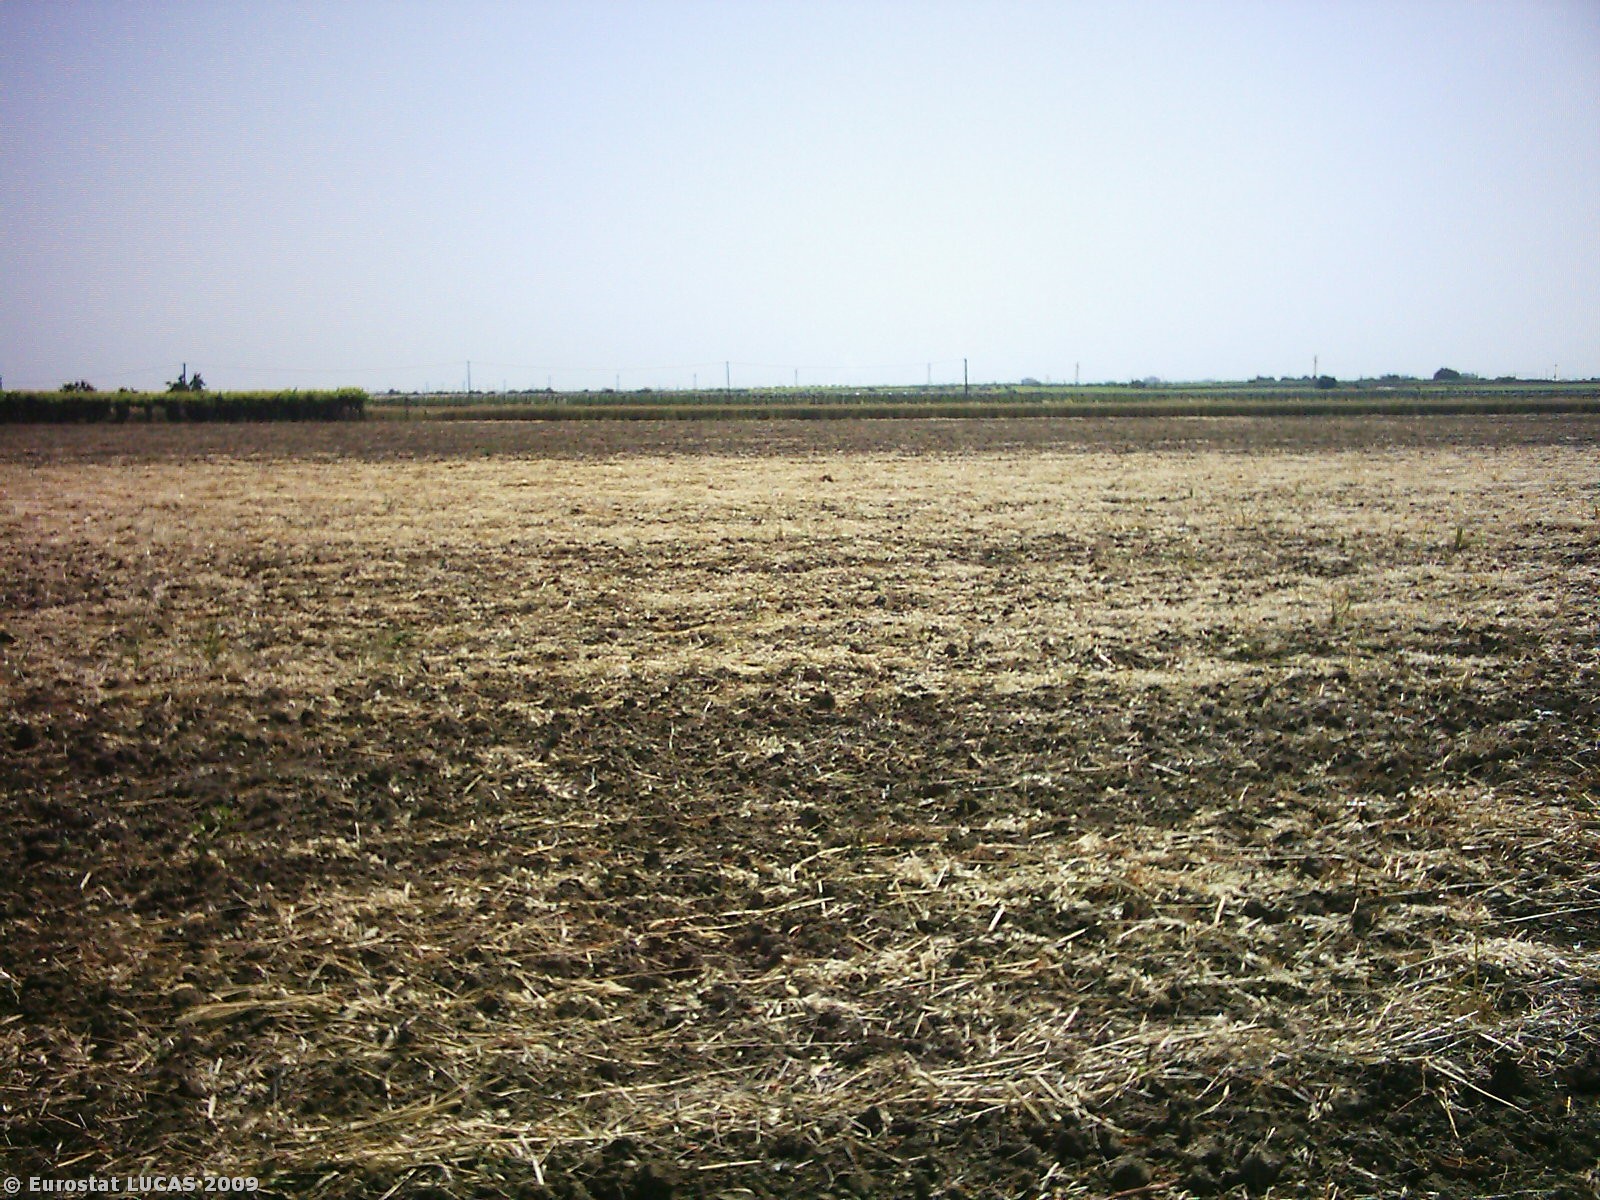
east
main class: Cropland
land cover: Temporary grasslands
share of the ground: < 10 %
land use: Agriculture (excluding fallow land and kitchen gardens)
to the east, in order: Temporary grasslands; Durum wheat
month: May
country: IT
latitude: 41.3369
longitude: 15.6572
